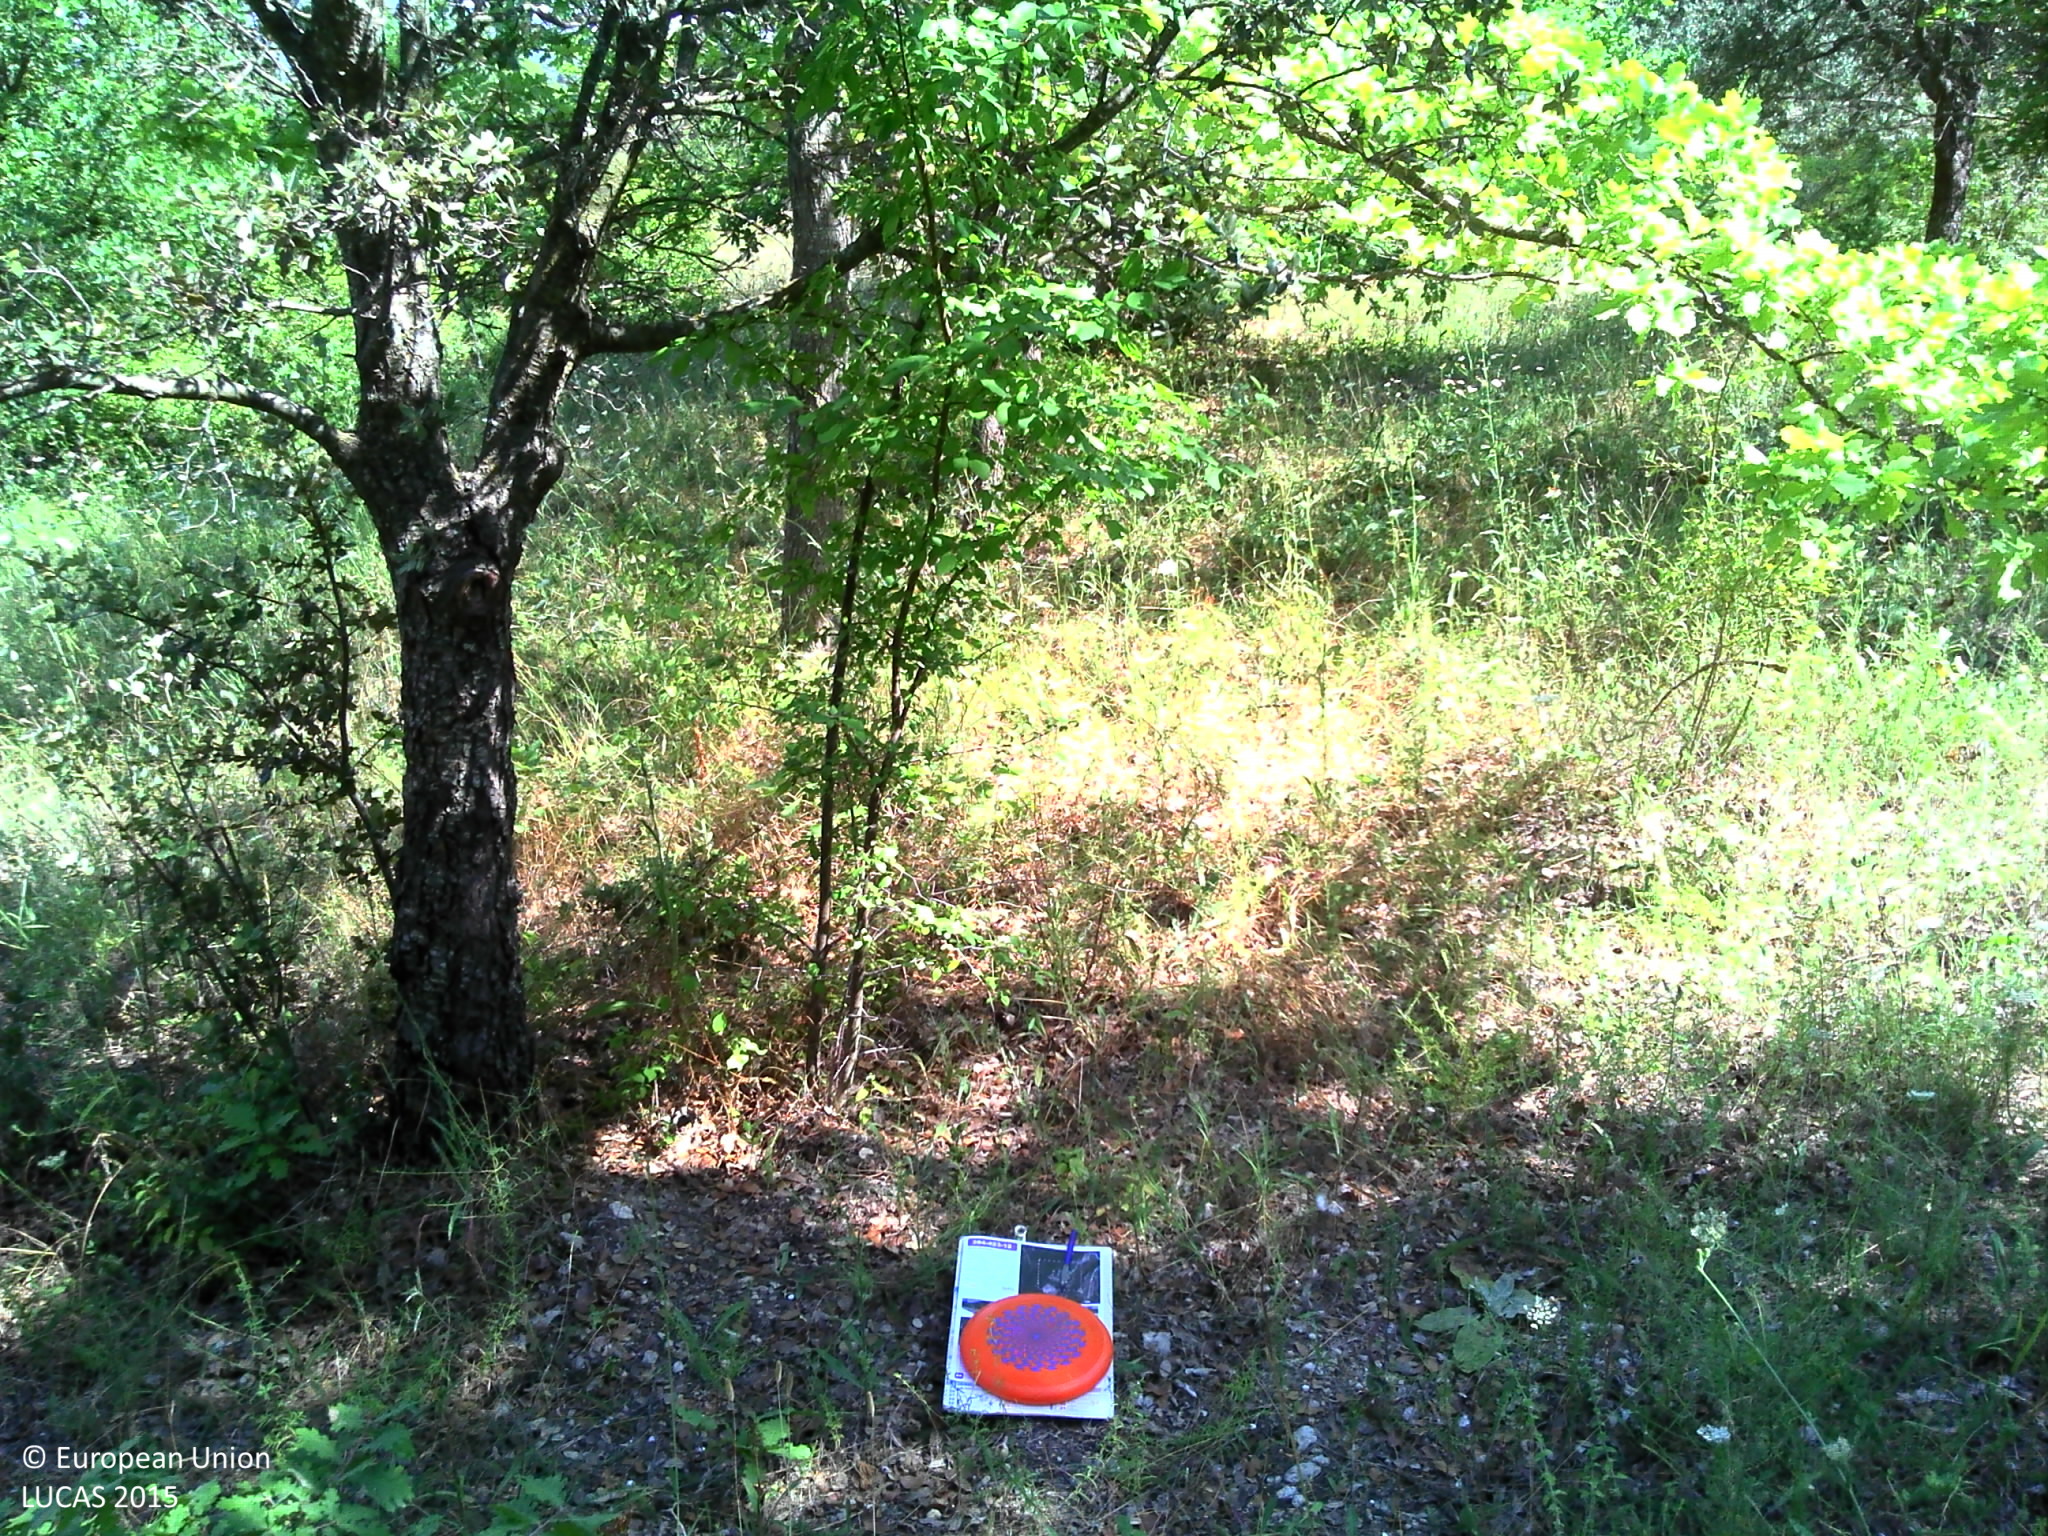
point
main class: Grassland
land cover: Grassland with sparse tree/shrub cover
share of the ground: > 75 %
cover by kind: herbaceous plants 95 %, broadleaved forest trees 5 %
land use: Agriculture (excluding fallow land and kitchen gardens)
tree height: < 5 m
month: August
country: FR
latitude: 43.8115
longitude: 5.3222
